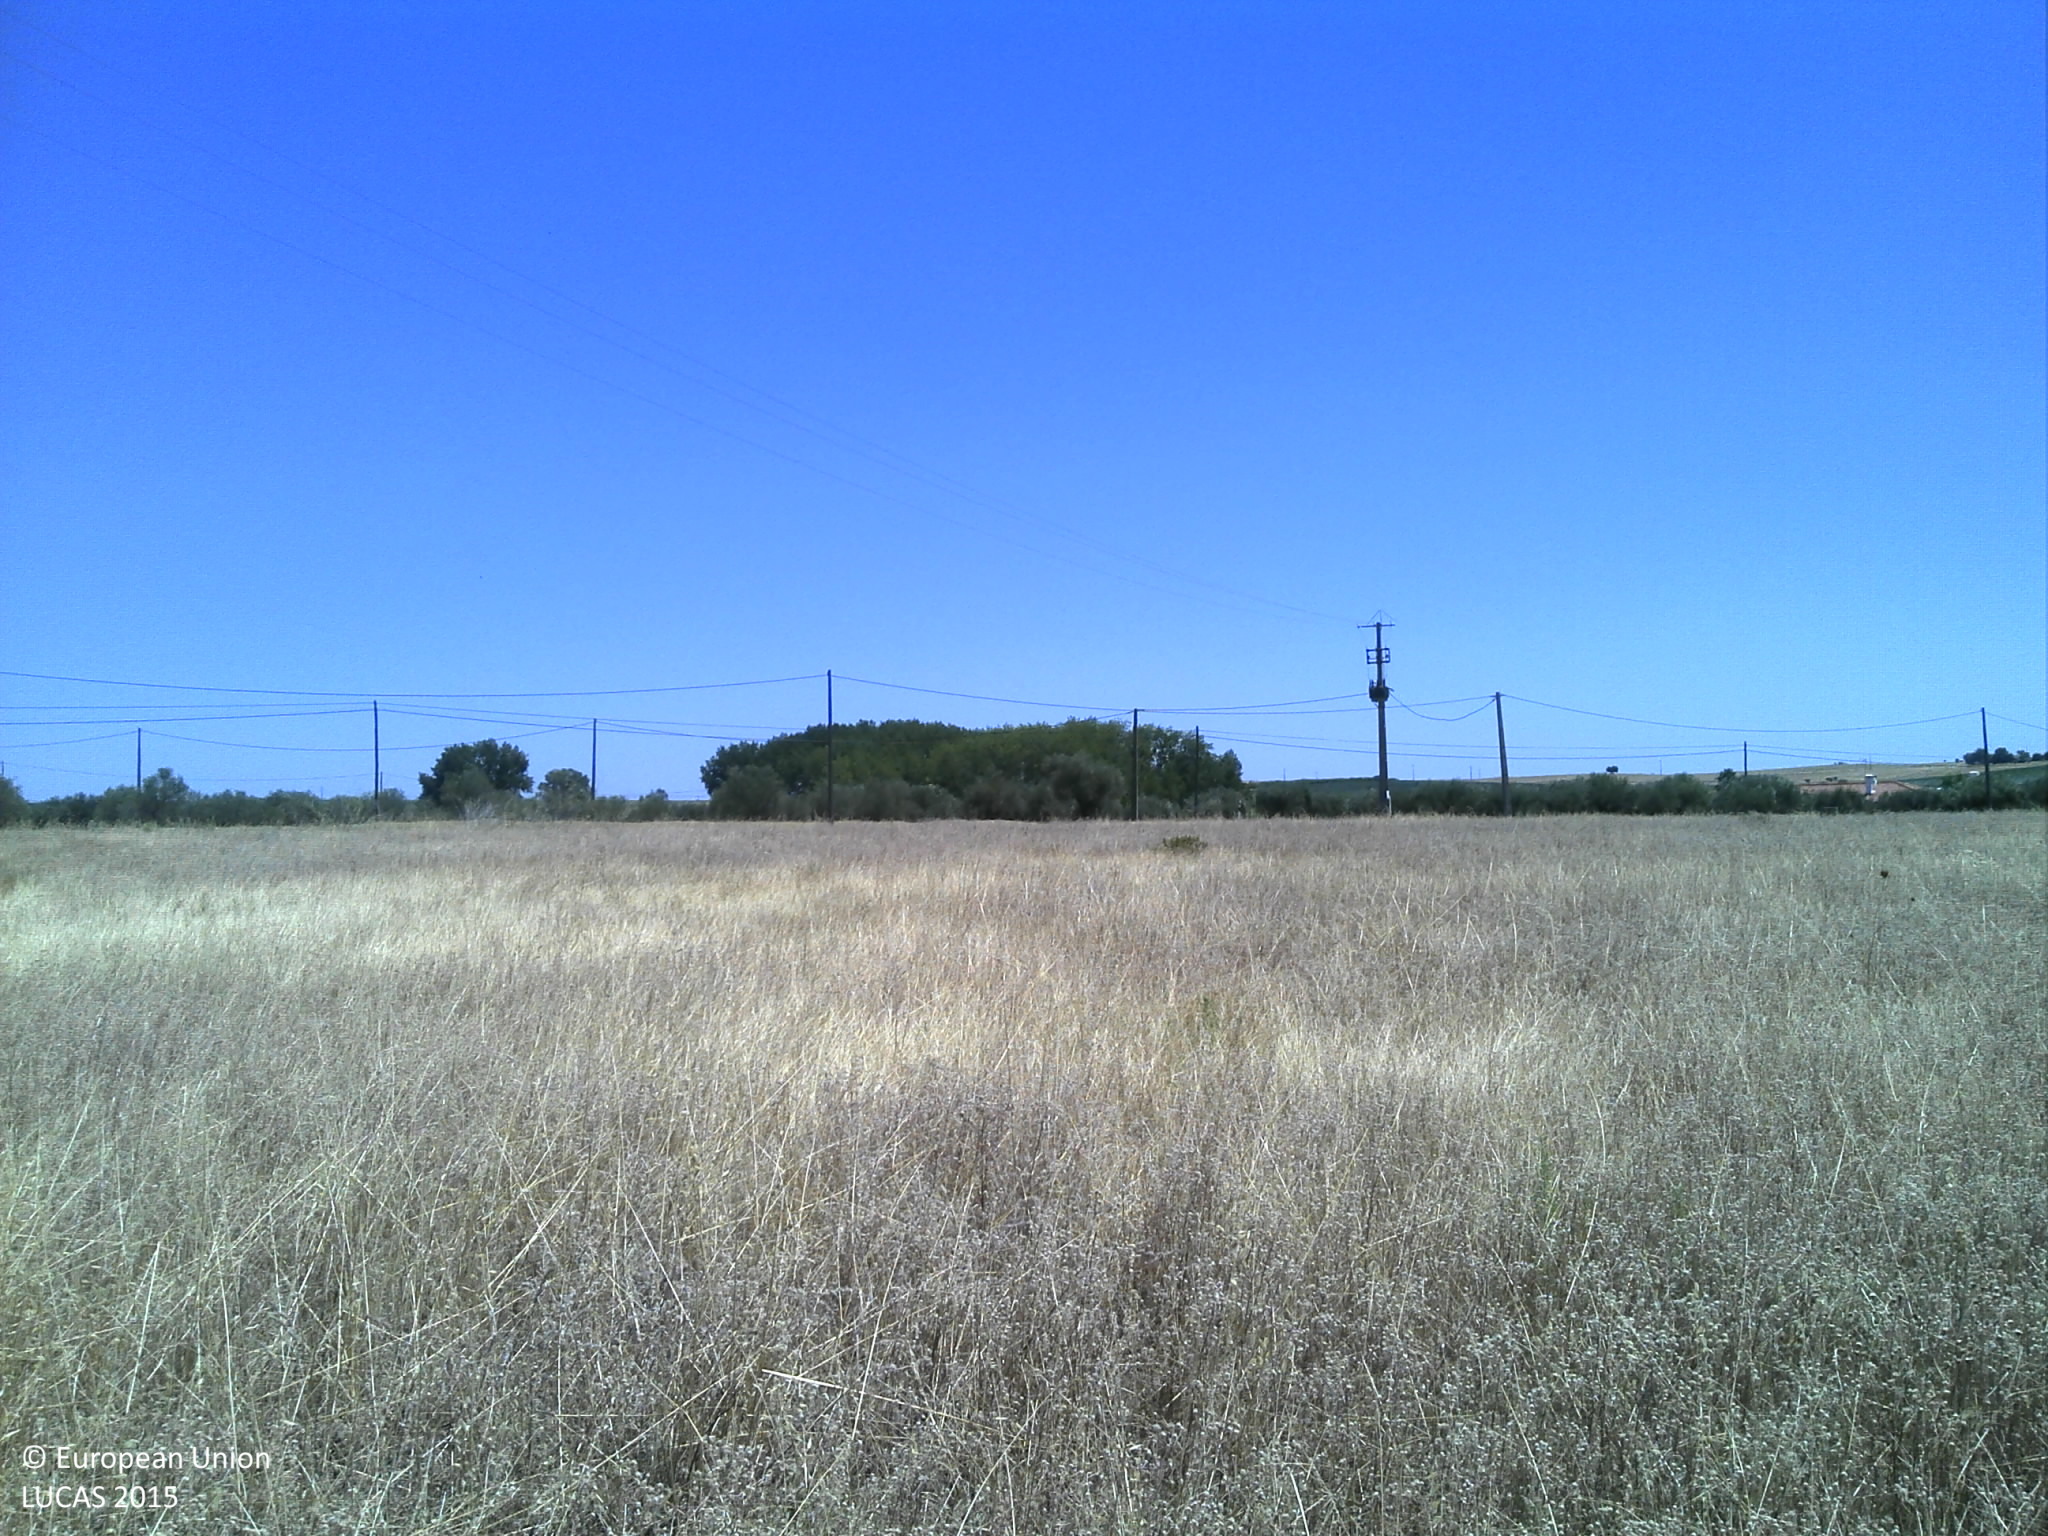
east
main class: Grassland
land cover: Spontaneously vegetated surfaces
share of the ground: 50 - 75 %
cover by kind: herbaceous plants 75 %, unconsolidated bare surface 25 %
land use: Fallow land
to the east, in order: Spontaneously vegetated surfaces; Electric lines; Spontaneously vegetated surfaces; Electric lines; Tracks; Grass margins; Paved roads, cycling and walking lanes; Grass margins; Electric lines; Tracks; Olive groves; Electric lines; Olive groves; Fences; Olive groves; Vineyards; Other fruit trees and berries
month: July
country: PT
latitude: 38.9653
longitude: -7.0501
